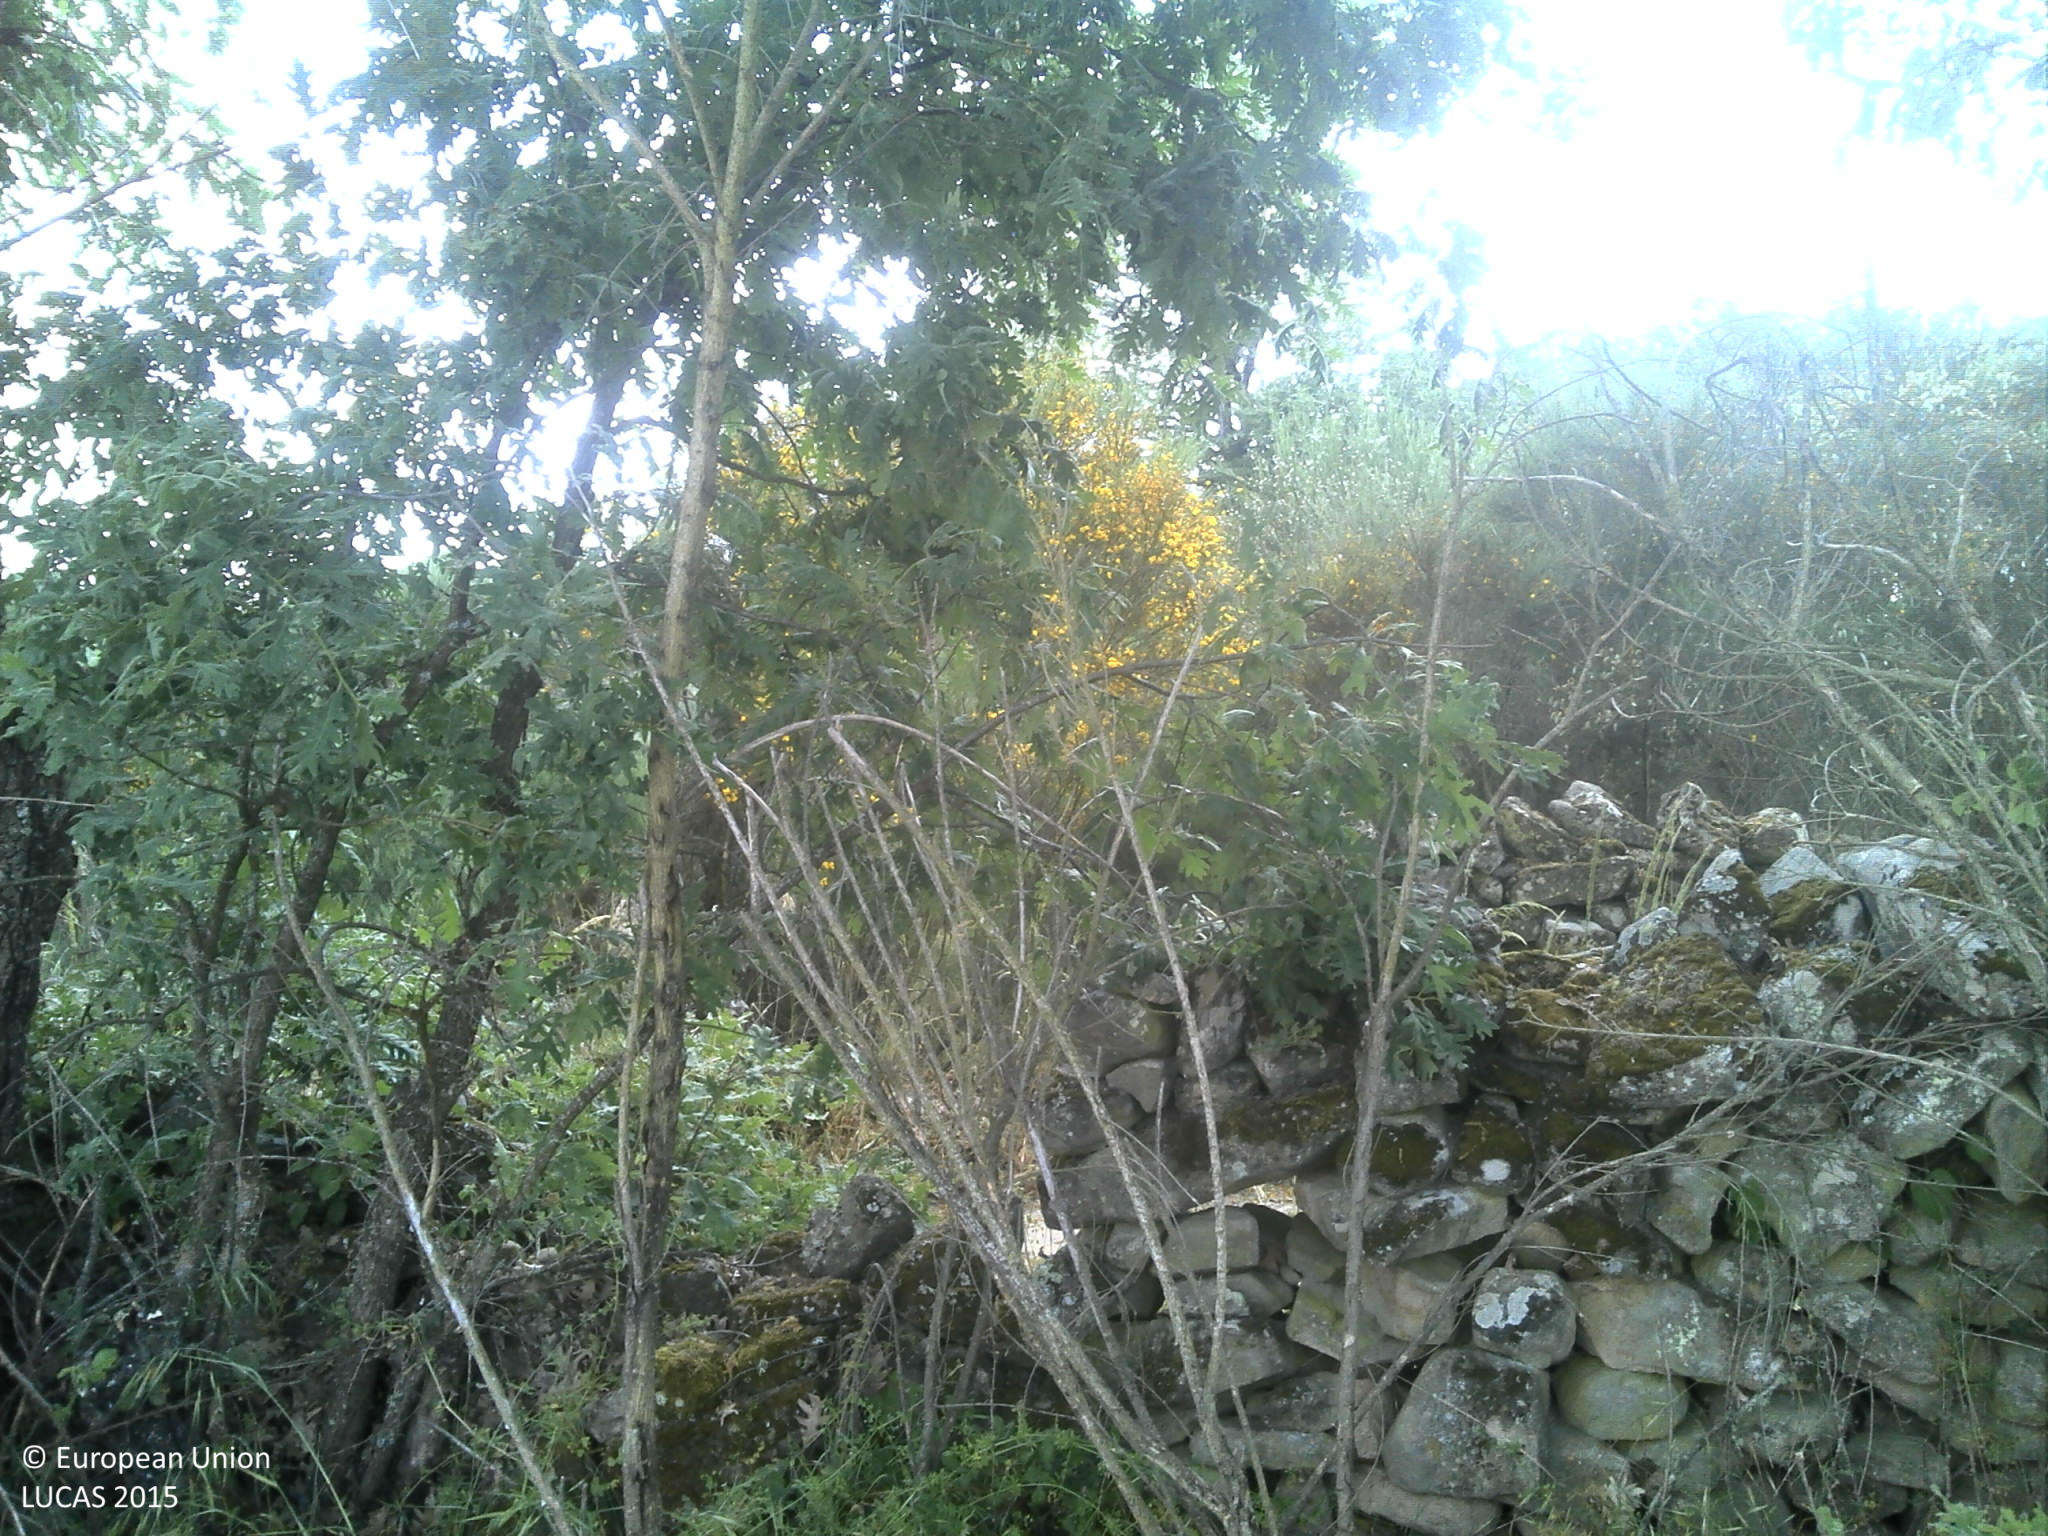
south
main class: Grassland
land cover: Grassland without tree/shrub cover
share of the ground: 50 - 75 %
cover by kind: herbaceous plants 75 %, unconsolidated bare surface 20 %, shrubs 5 %
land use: Agriculture (excluding fallow land and kitchen gardens)
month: June
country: PT
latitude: 40.5002
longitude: -7.1290
